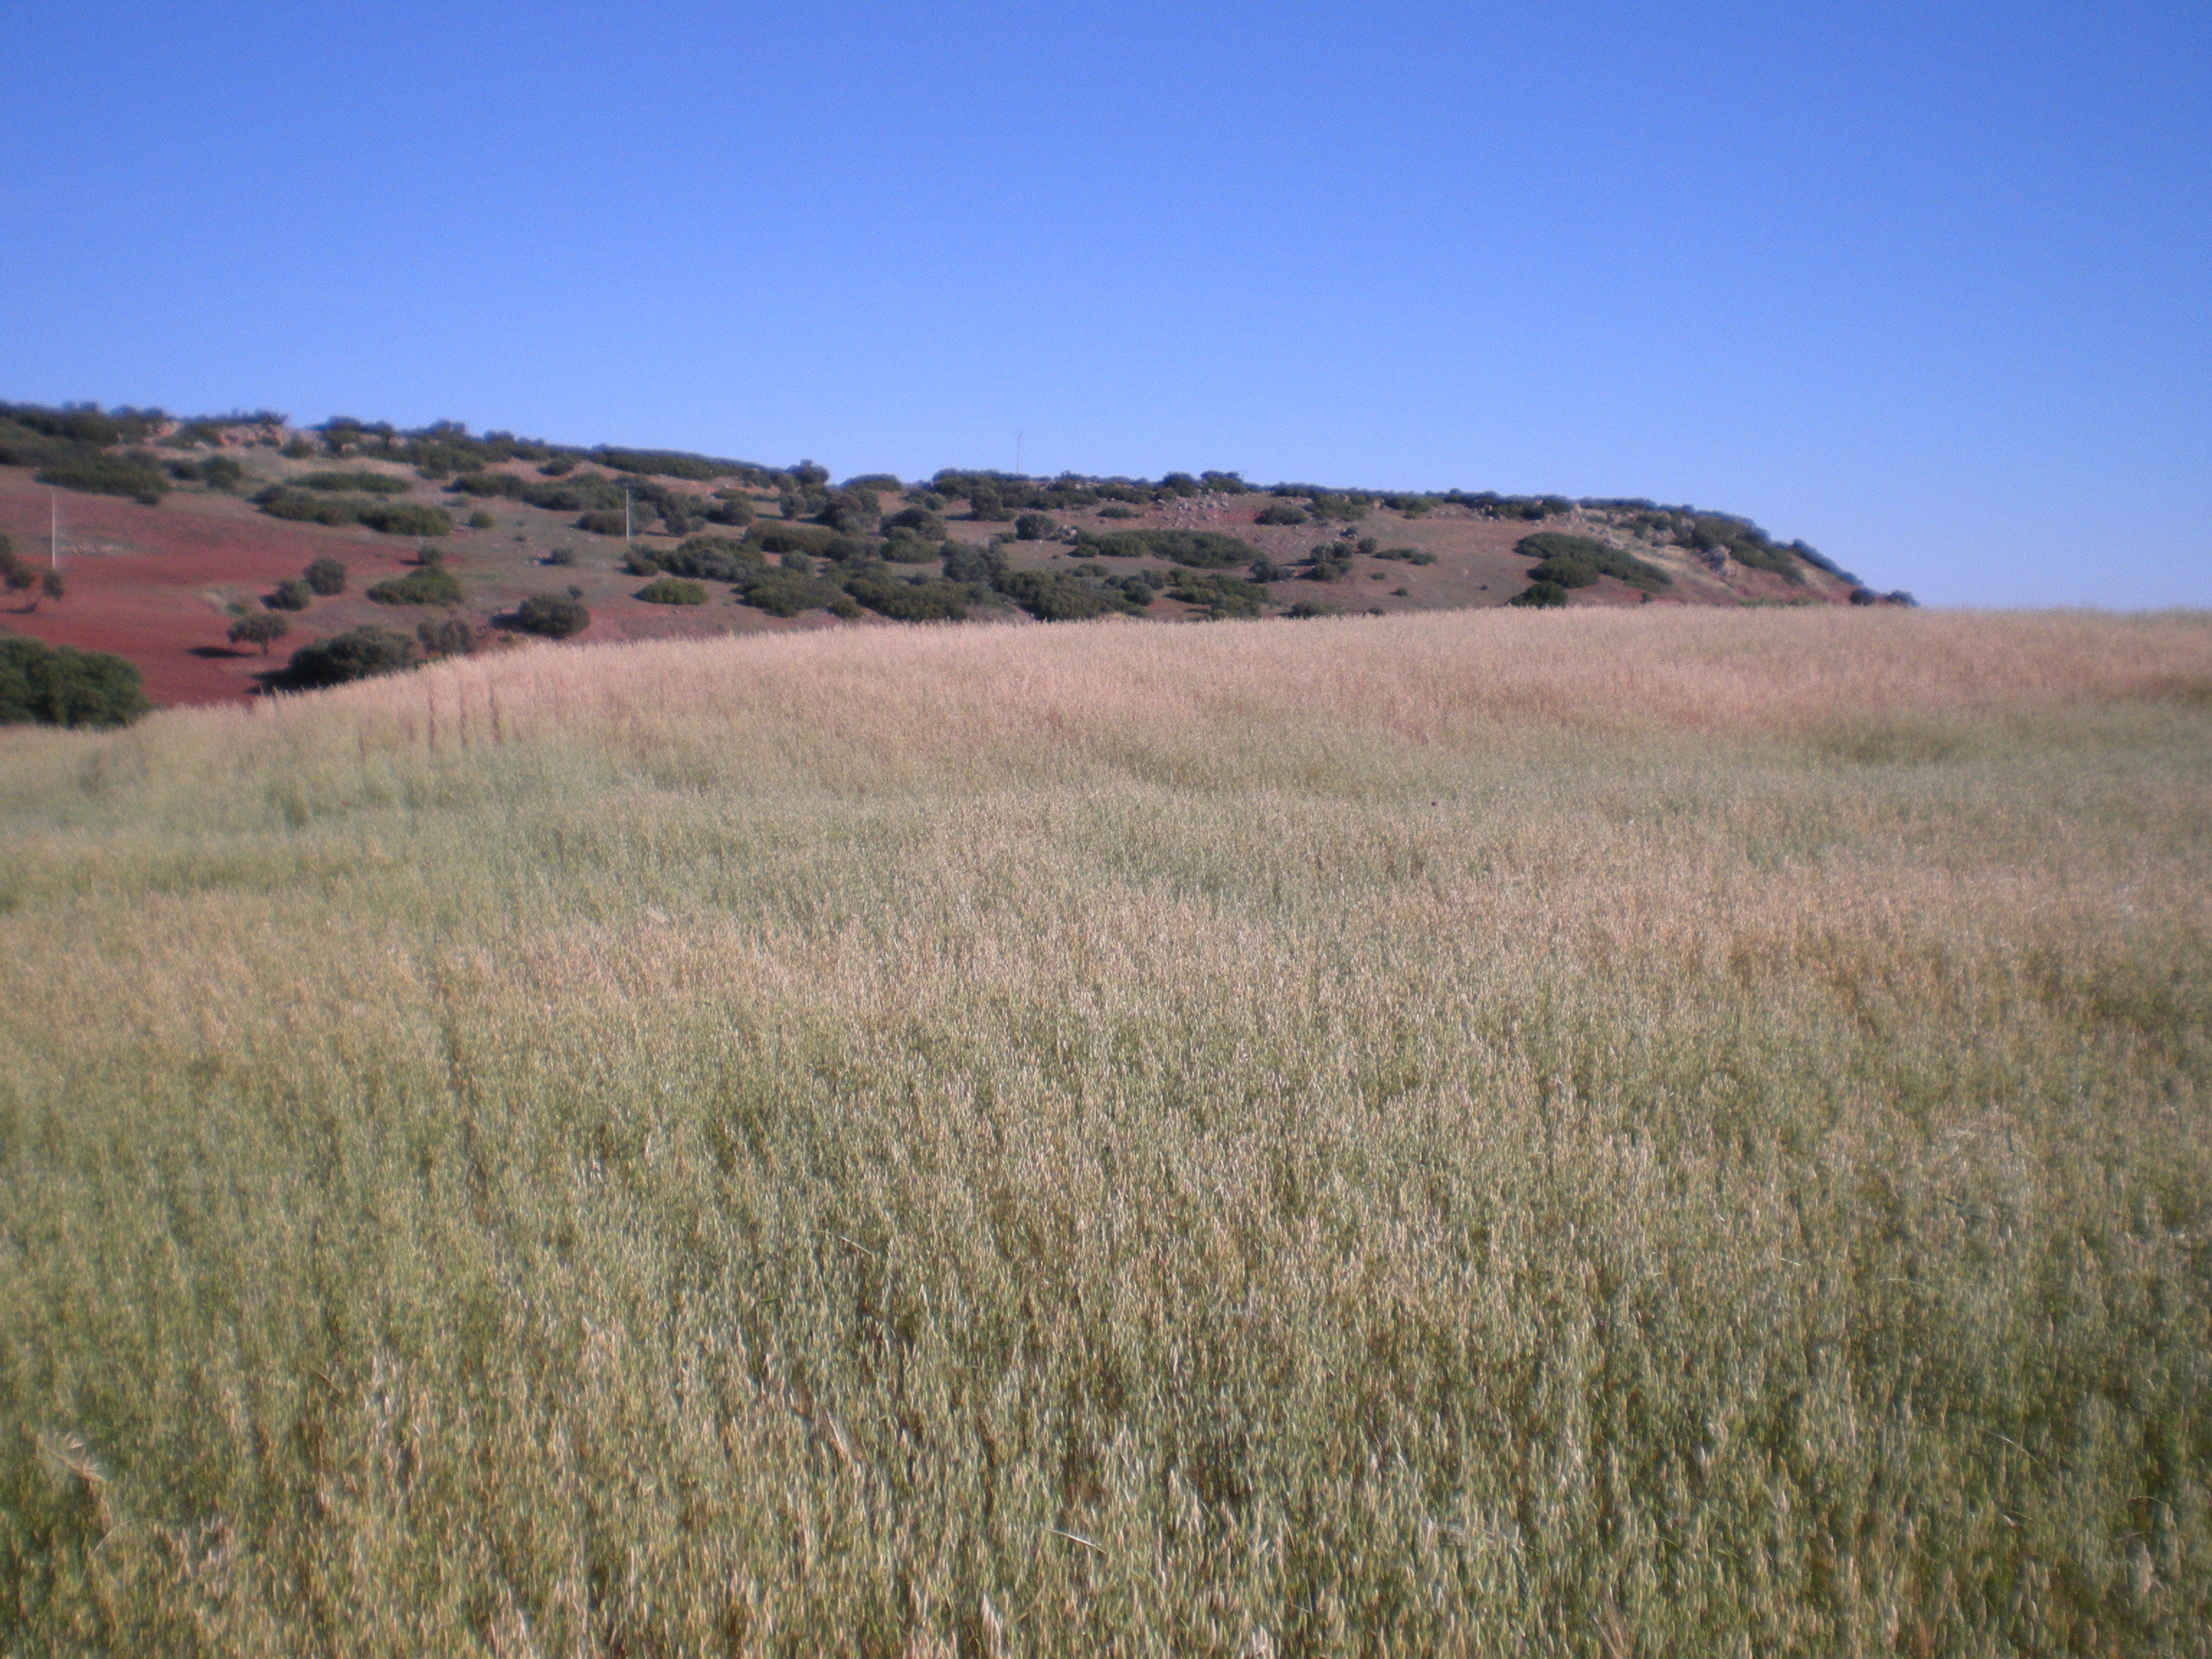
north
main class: Cropland
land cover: Oats
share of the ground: > 75 %
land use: Agriculture (excluding fallow land and kitchen gardens)
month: May
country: ES
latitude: 38.6807
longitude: -2.8910
